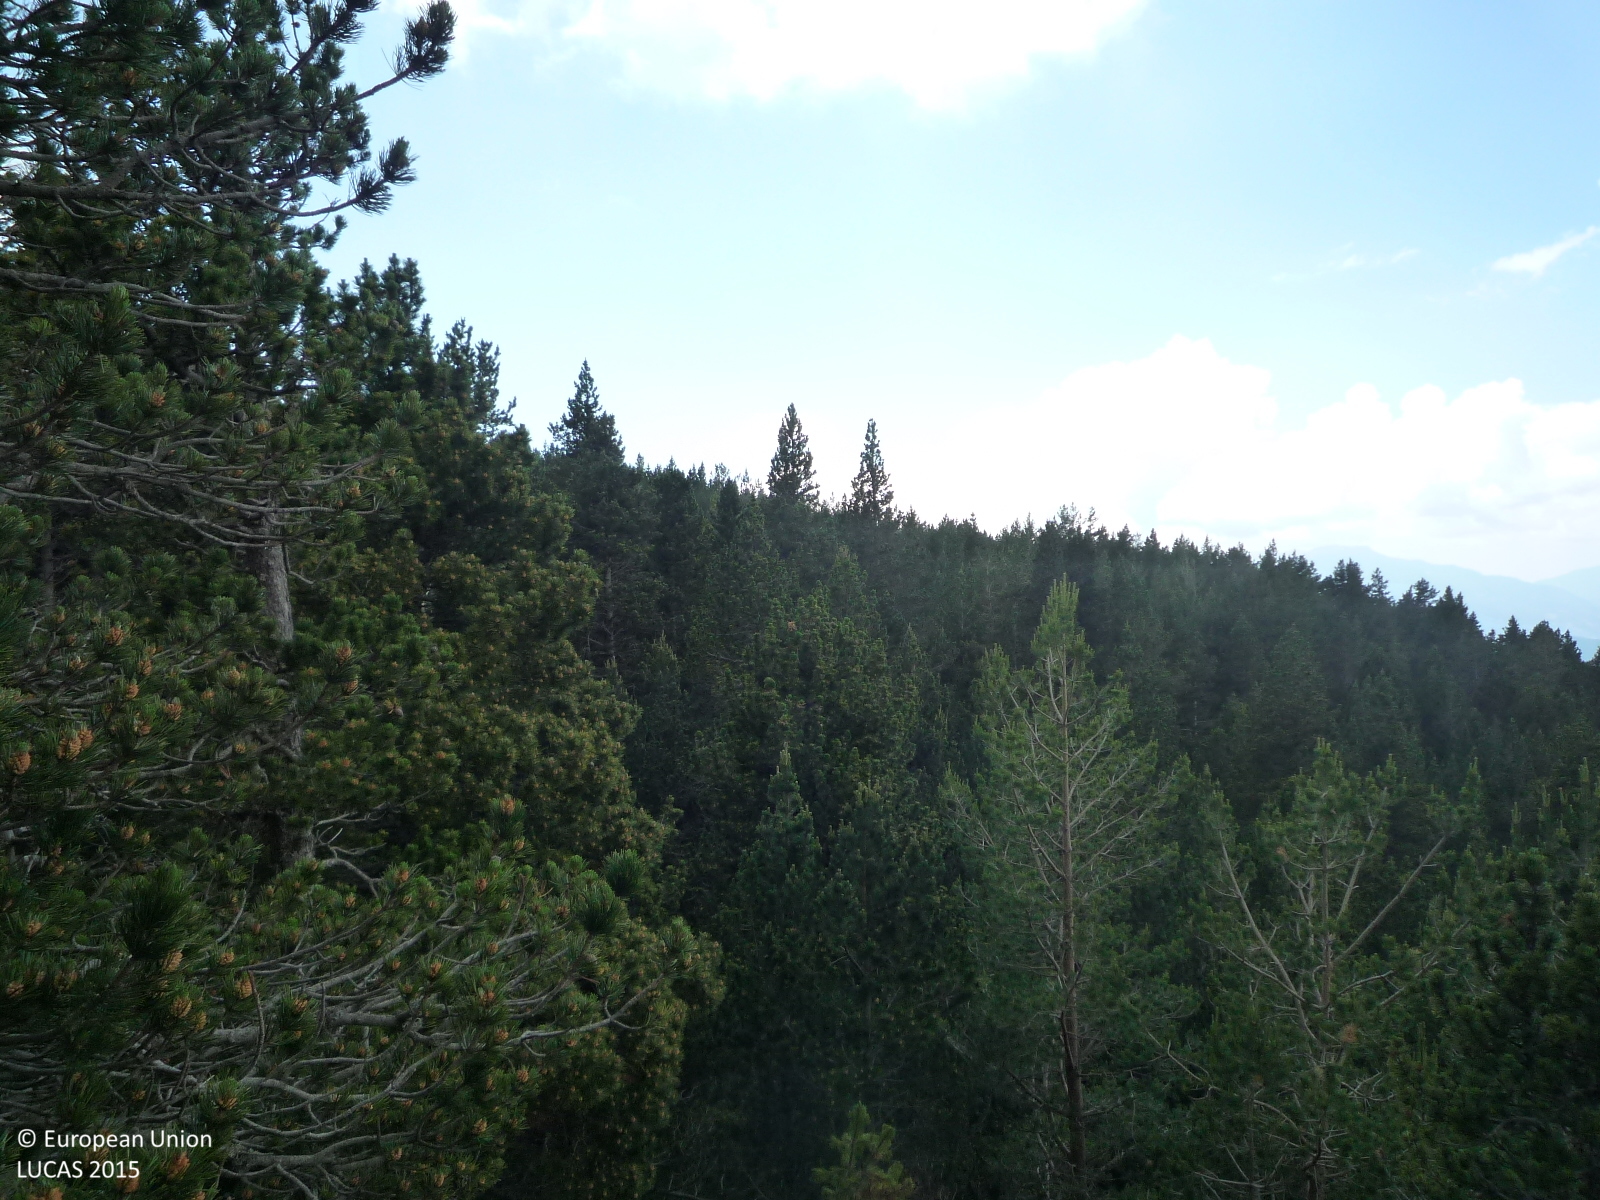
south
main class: Woodland
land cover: Pine dominated coniferous woodland
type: alpine coniferous forest
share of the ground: > 75 %
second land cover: Grassland without tree/shrub cover
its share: 50 - 75 %
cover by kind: coniferous forest trees 70 %, herbaceous plants 30 %
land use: Forestry
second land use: Agriculture (excluding fallow land and kitchen gardens)
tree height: < 5 m
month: June
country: ES
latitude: 42.2927
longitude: 1.8979
